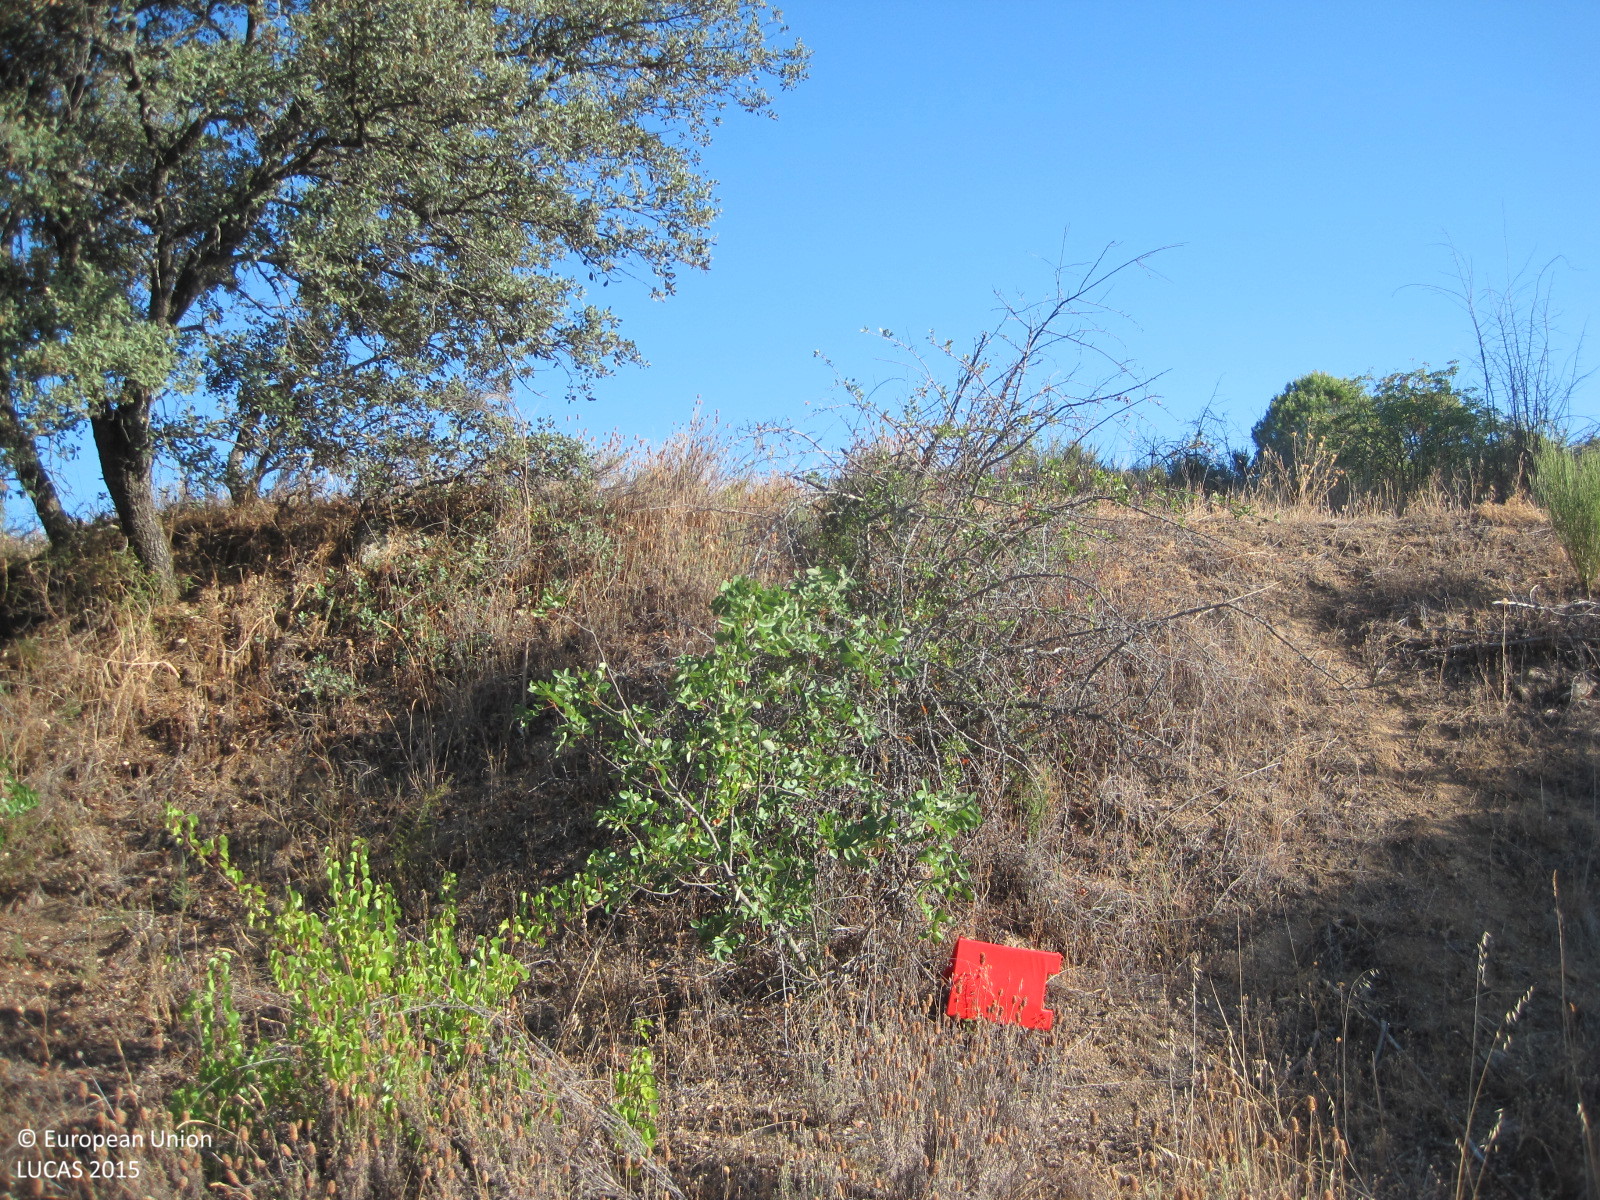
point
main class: Shrubland
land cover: Shrubland with sparse tree cover
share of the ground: > 75 %
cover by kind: shrubs 95 %, coniferous forest trees 5 %
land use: Semi-natural and natural areas not in use
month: July
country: ES
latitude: 40.2624
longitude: -4.4024
